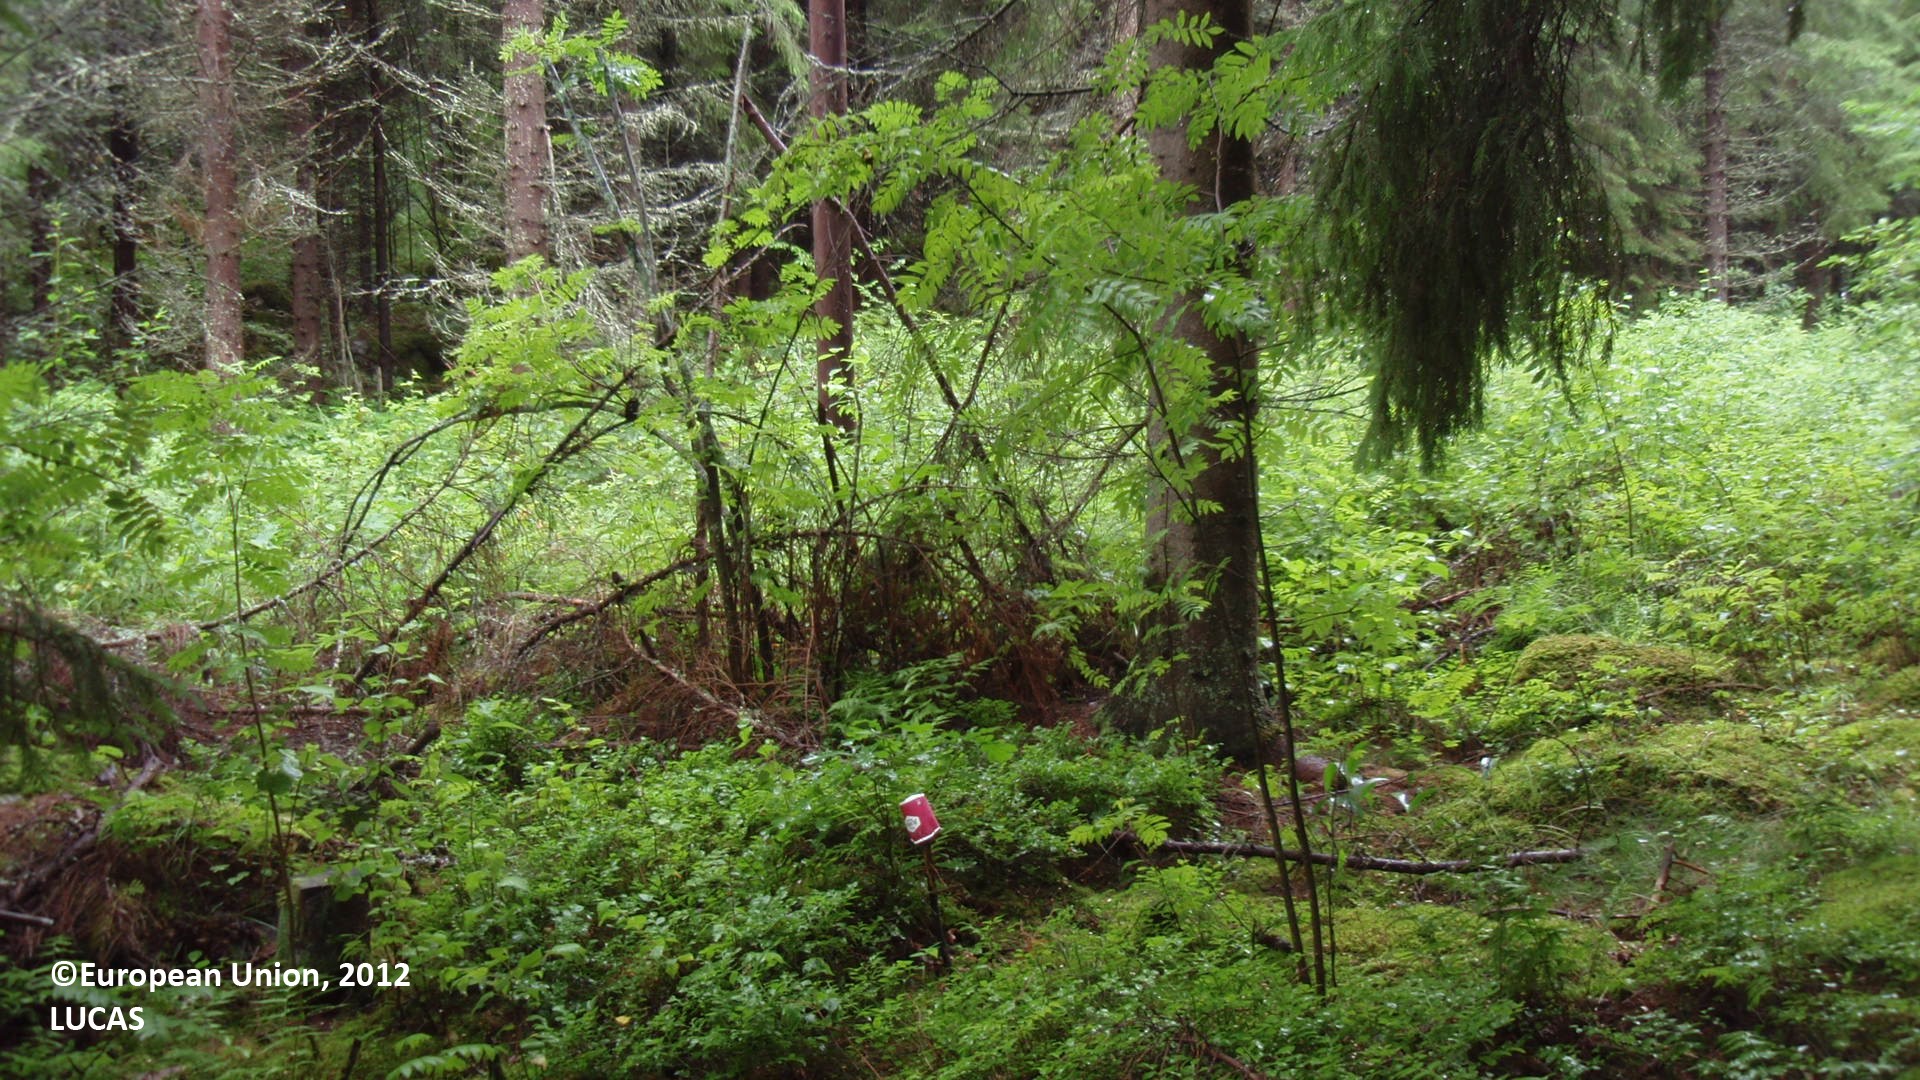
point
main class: Woodland
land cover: Spruce dominated coniferous woodland
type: boreal forest
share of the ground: > 75 %
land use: Forestry
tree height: > 5 m
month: July
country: FI
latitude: 61.6373
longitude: 27.2844
